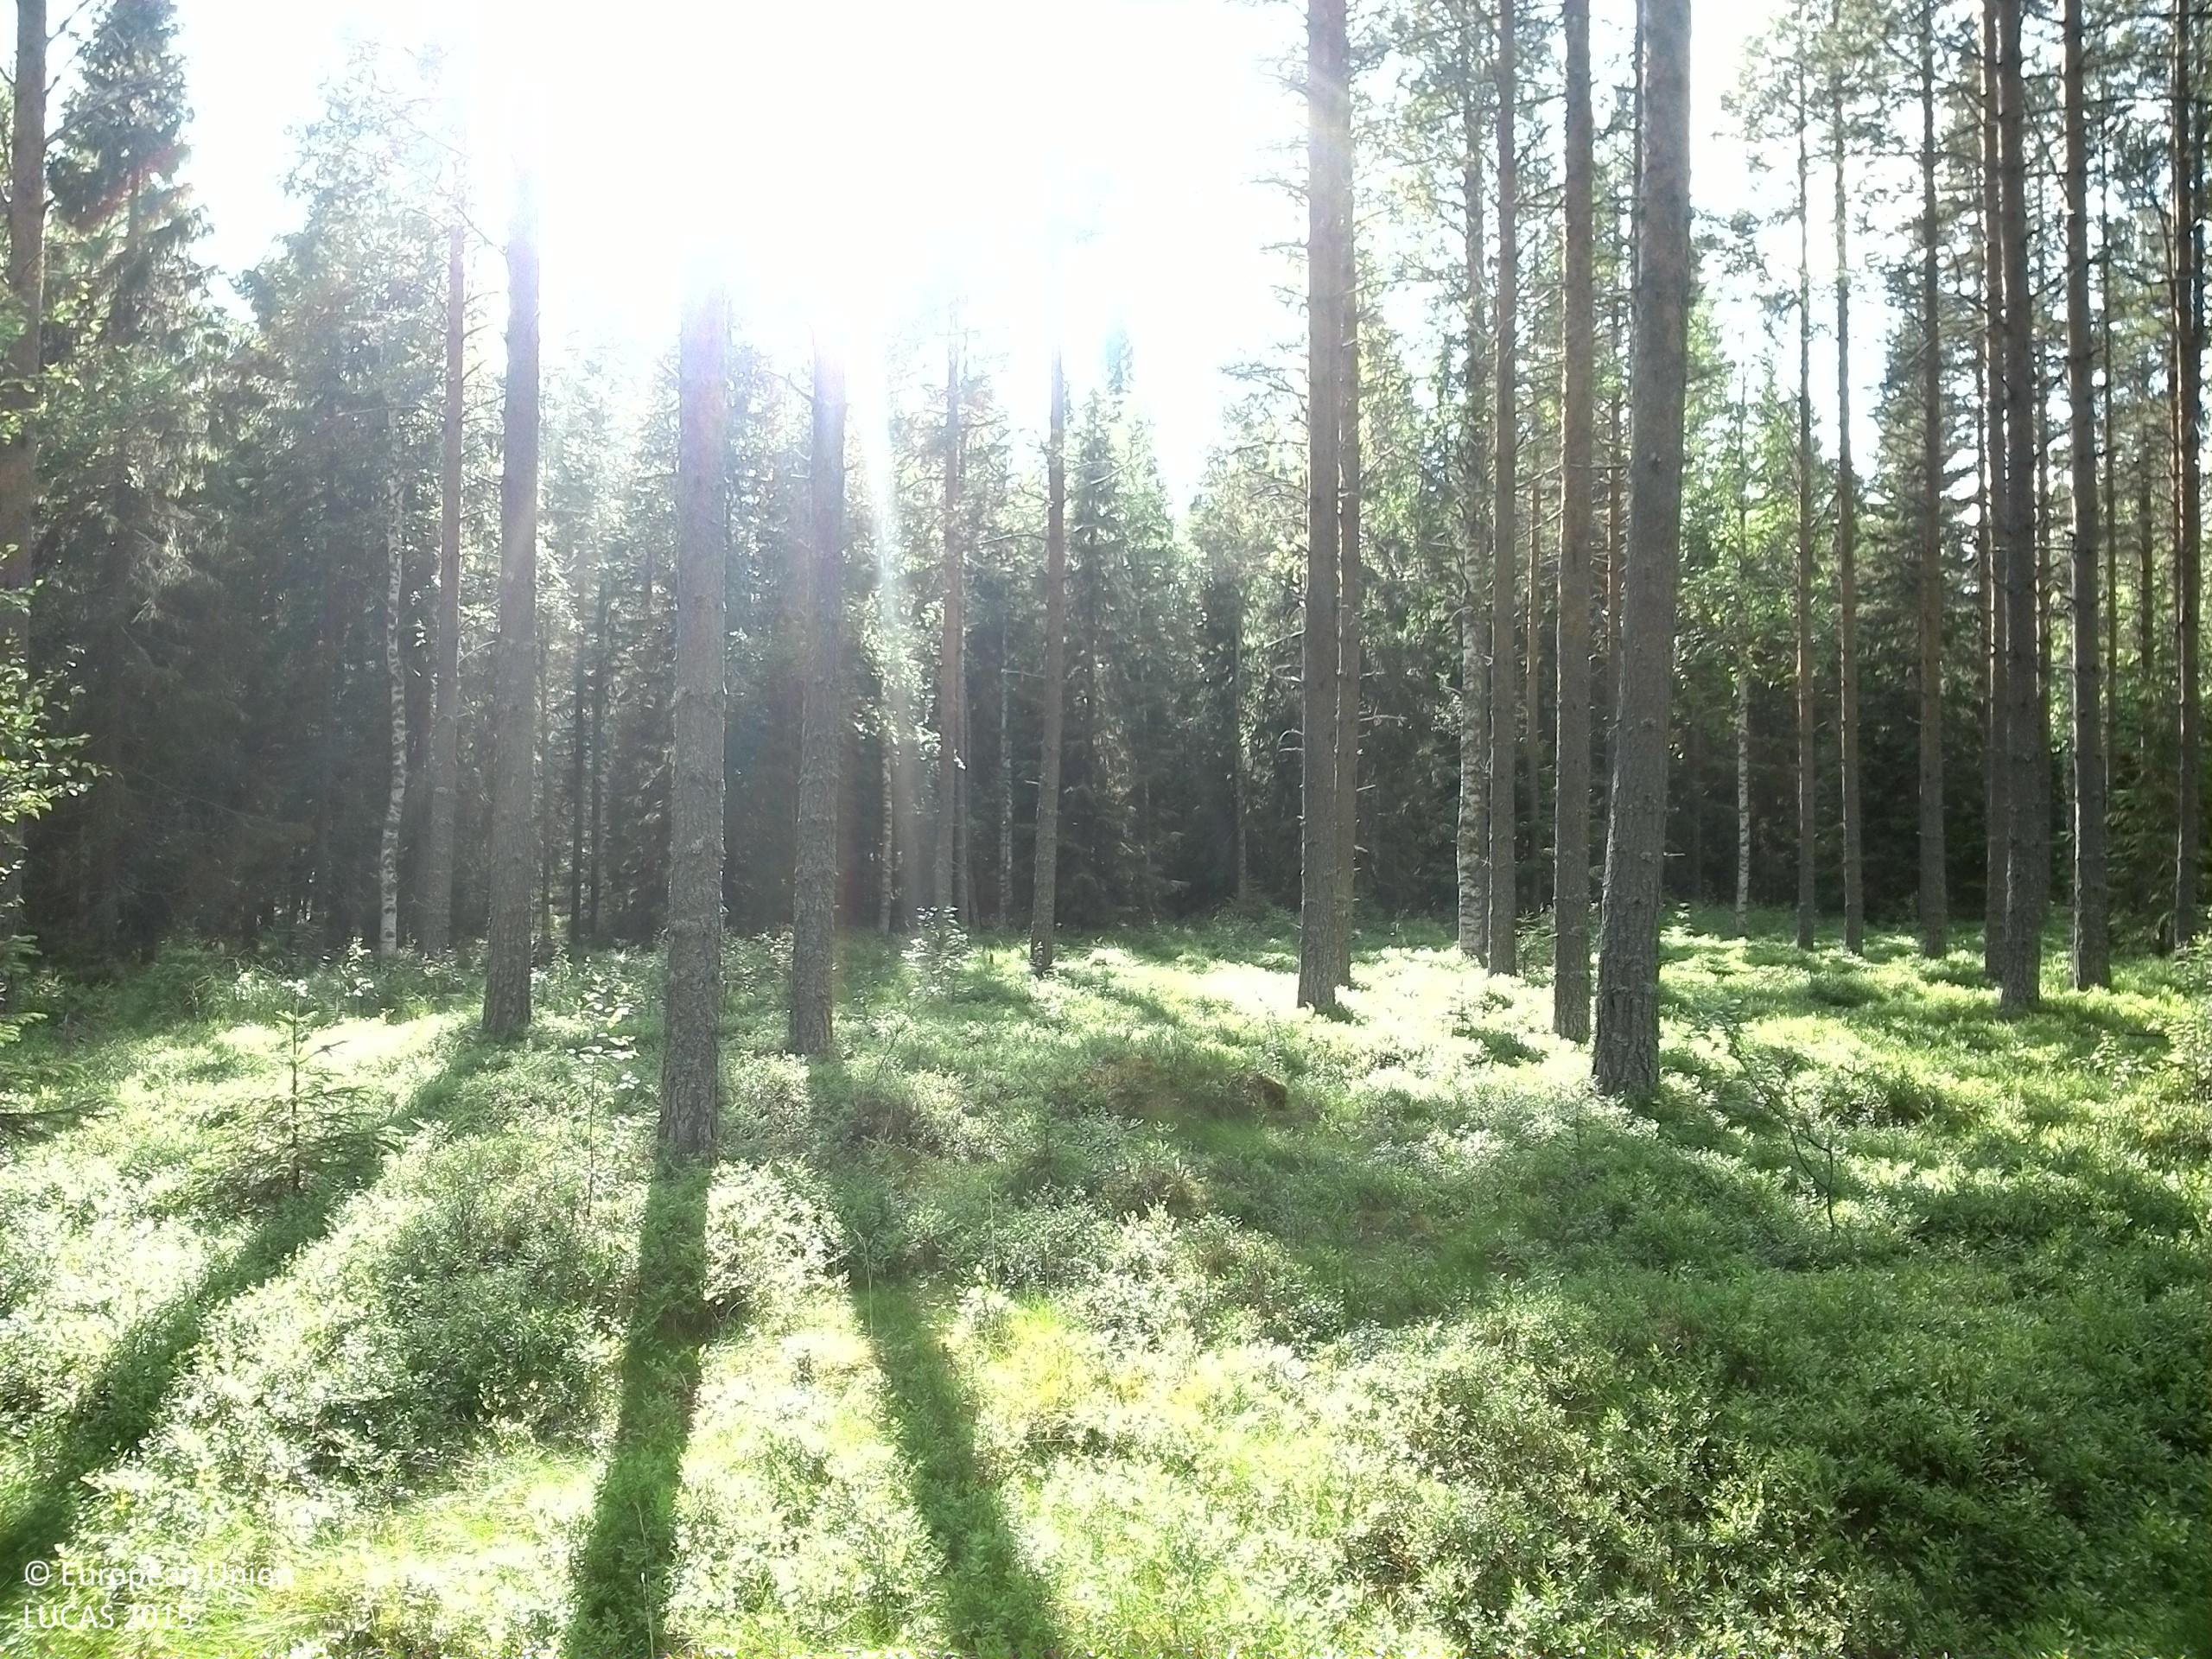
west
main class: Woodland
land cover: Pine dominated coniferous woodland
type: boreal forest
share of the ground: 50 - 75 %
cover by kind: coniferous forest trees 60 %, shrubs 35 %, broadleaved forest trees 5 %
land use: Forestry
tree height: > 5 m
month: July
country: SE
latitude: 63.5306
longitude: 17.5148
